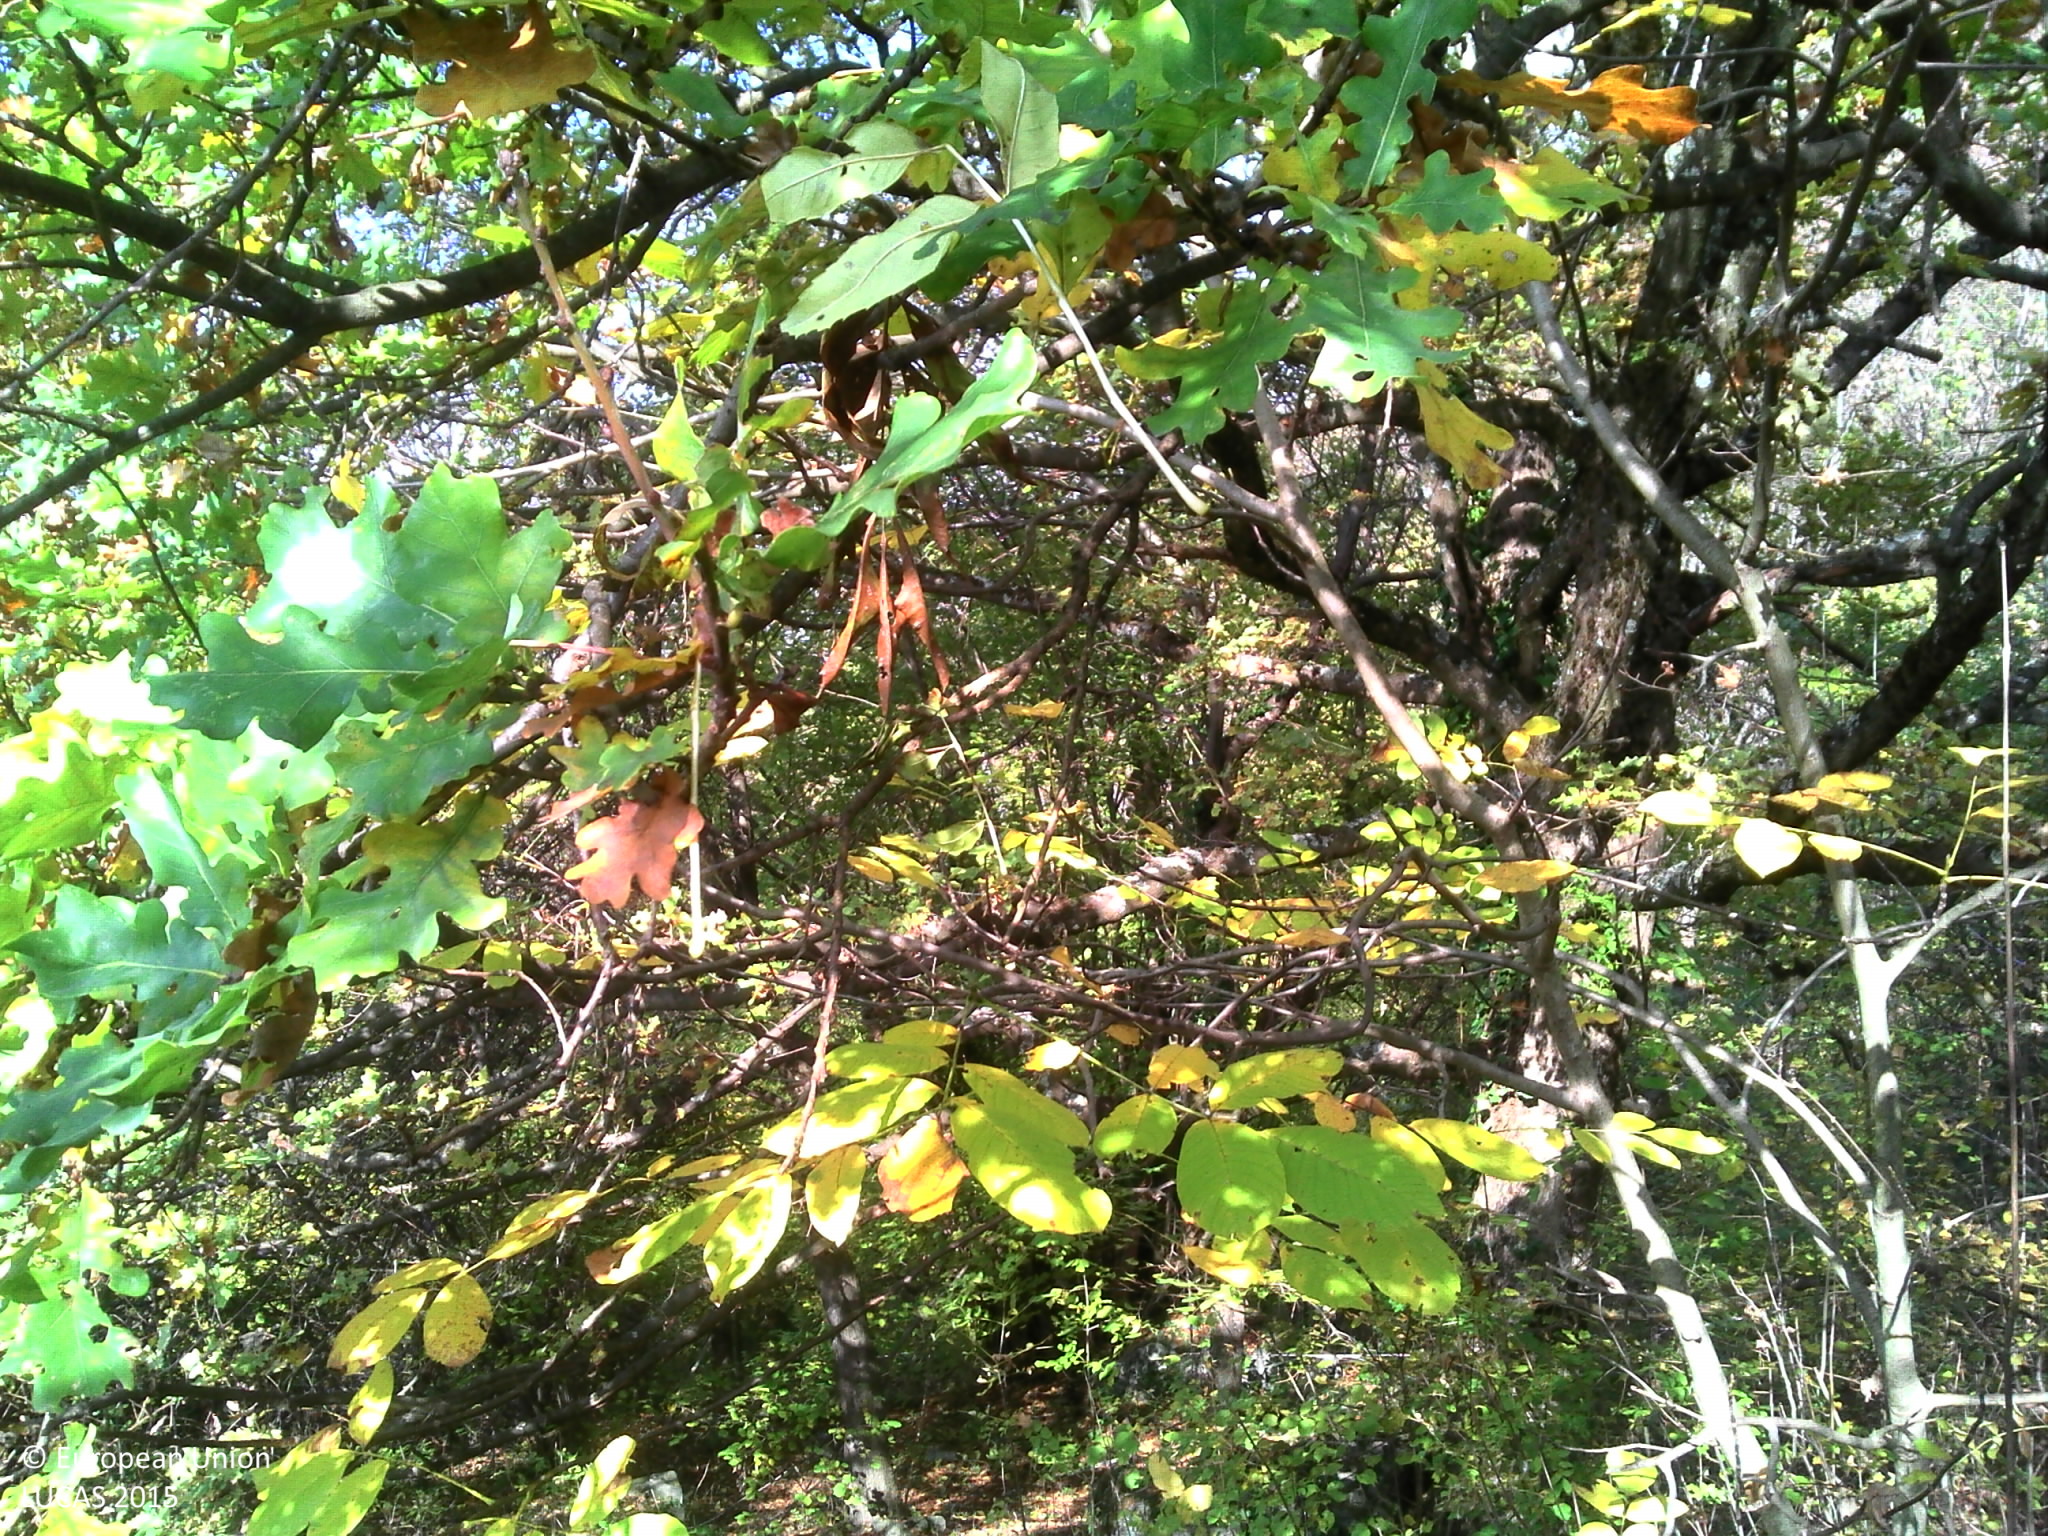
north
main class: Woodland
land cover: Broadleaved woodland
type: mesophytic deciduous forest
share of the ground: > 75 %
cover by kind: broadleaved forest trees 90 %, shrubs 5 %, consolidated bare surface 5 %
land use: Forestry
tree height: > 5 m
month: October
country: FR
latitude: 45.4031
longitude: 6.2871
